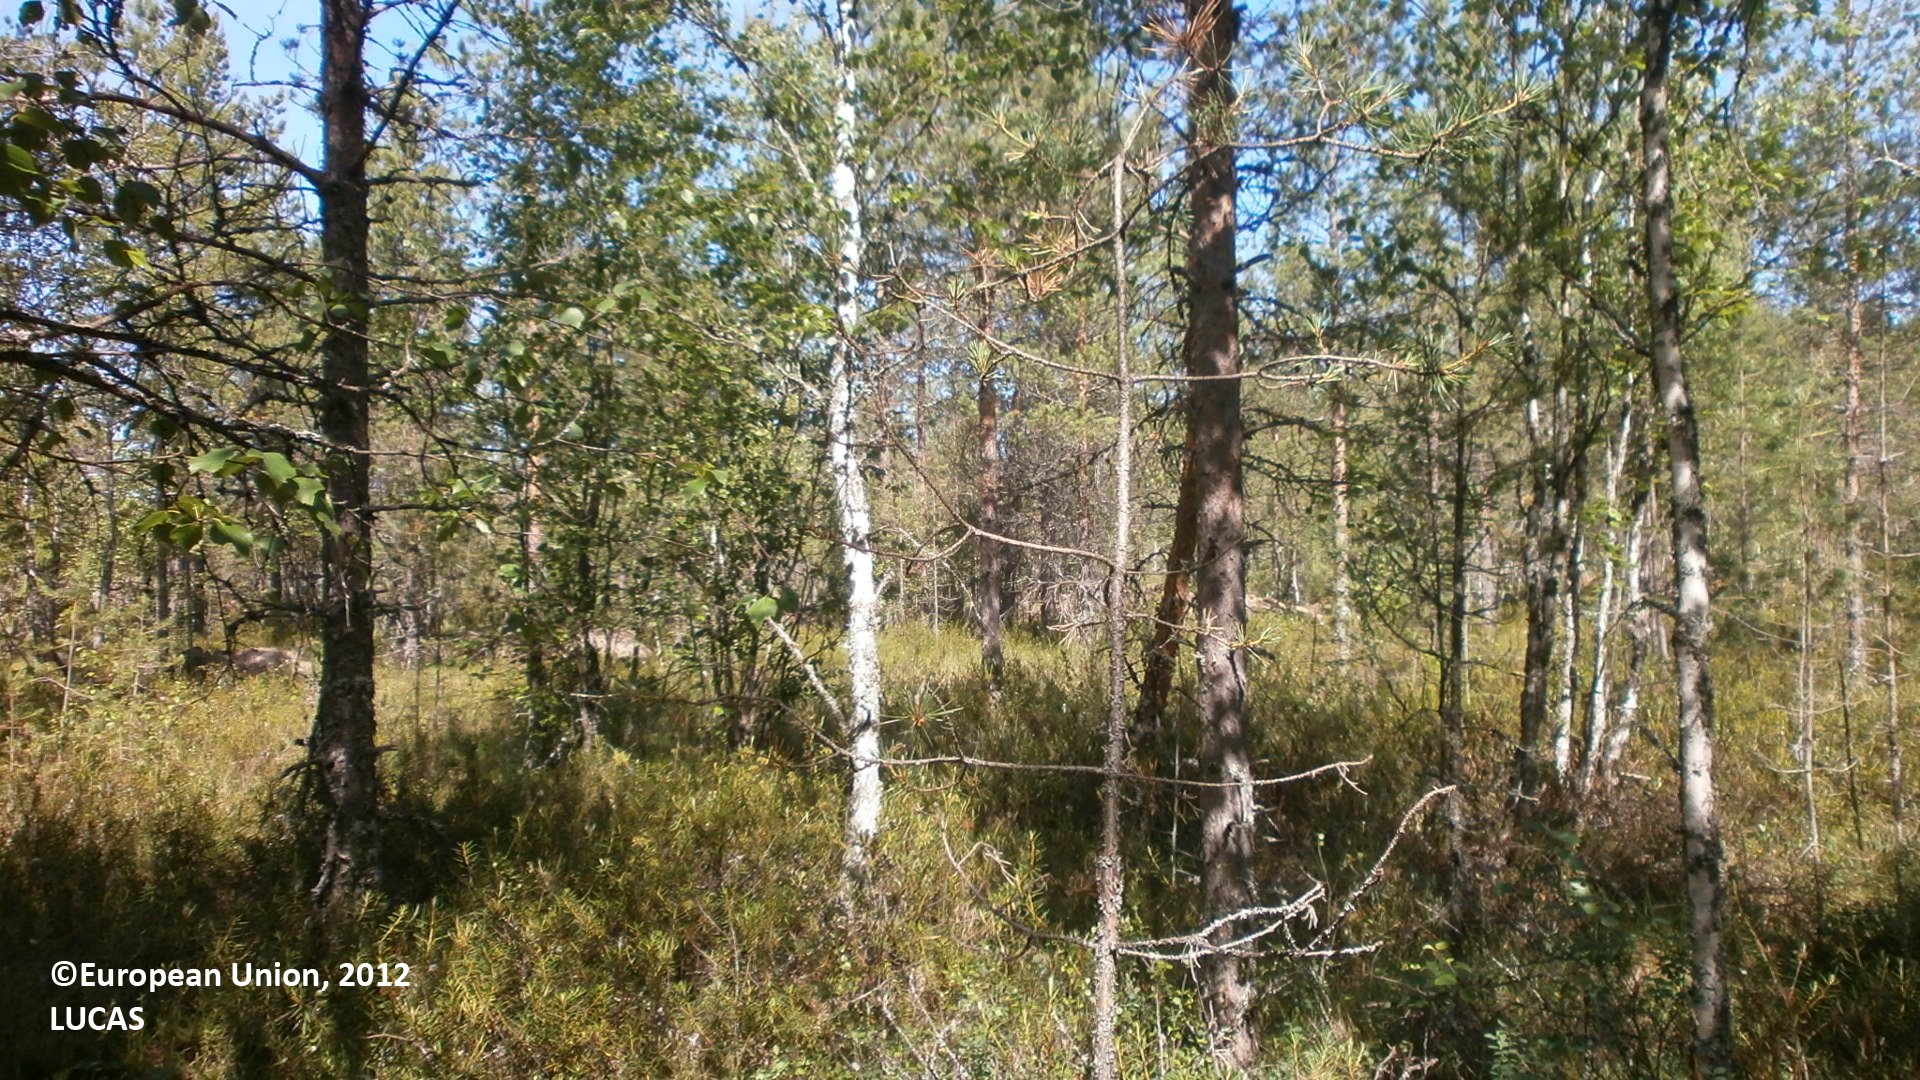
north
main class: Woodland
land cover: Pine dominated mixed woodland
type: mire and swamp forests
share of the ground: 50 - 75 %
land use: Forestry
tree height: > 5 m
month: July
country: FI
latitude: 64.2738
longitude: 24.1681
